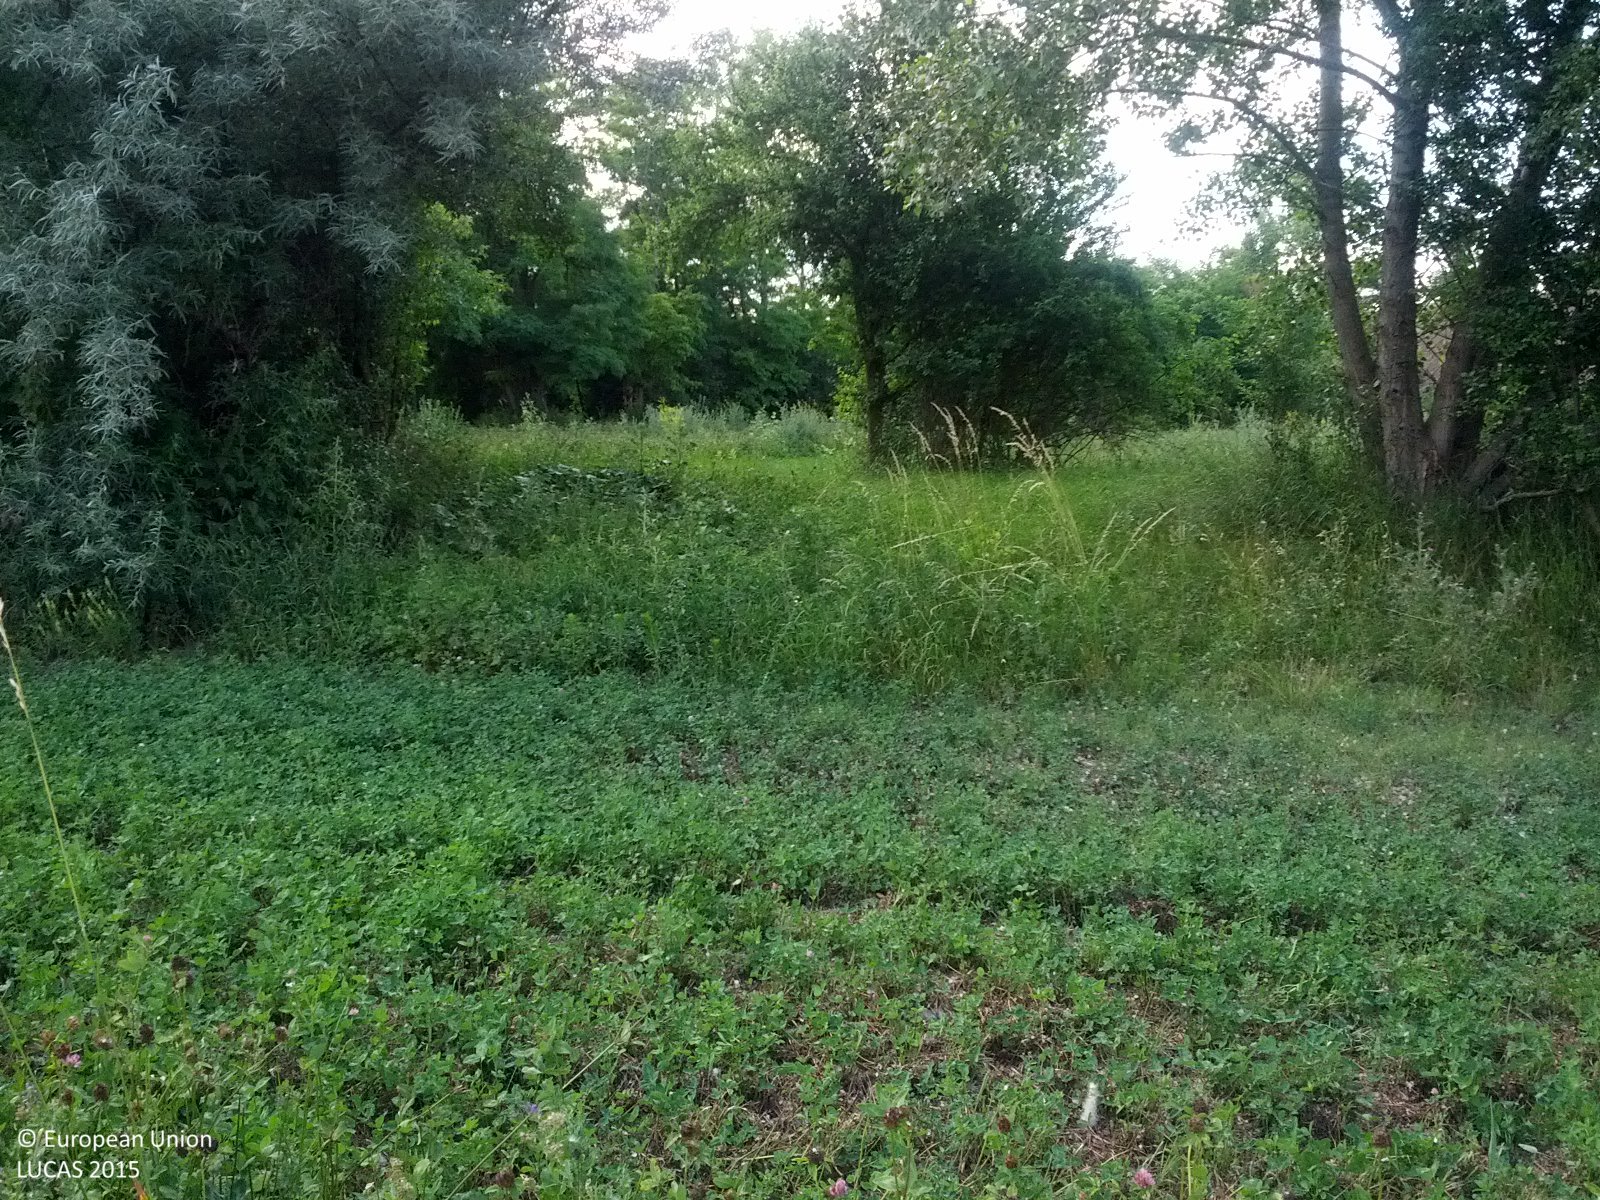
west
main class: Cropland
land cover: Clovers
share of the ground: > 75 %
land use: Agriculture (excluding fallow land and kitchen gardens)
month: June
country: AT
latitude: 48.3797
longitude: 16.7171
